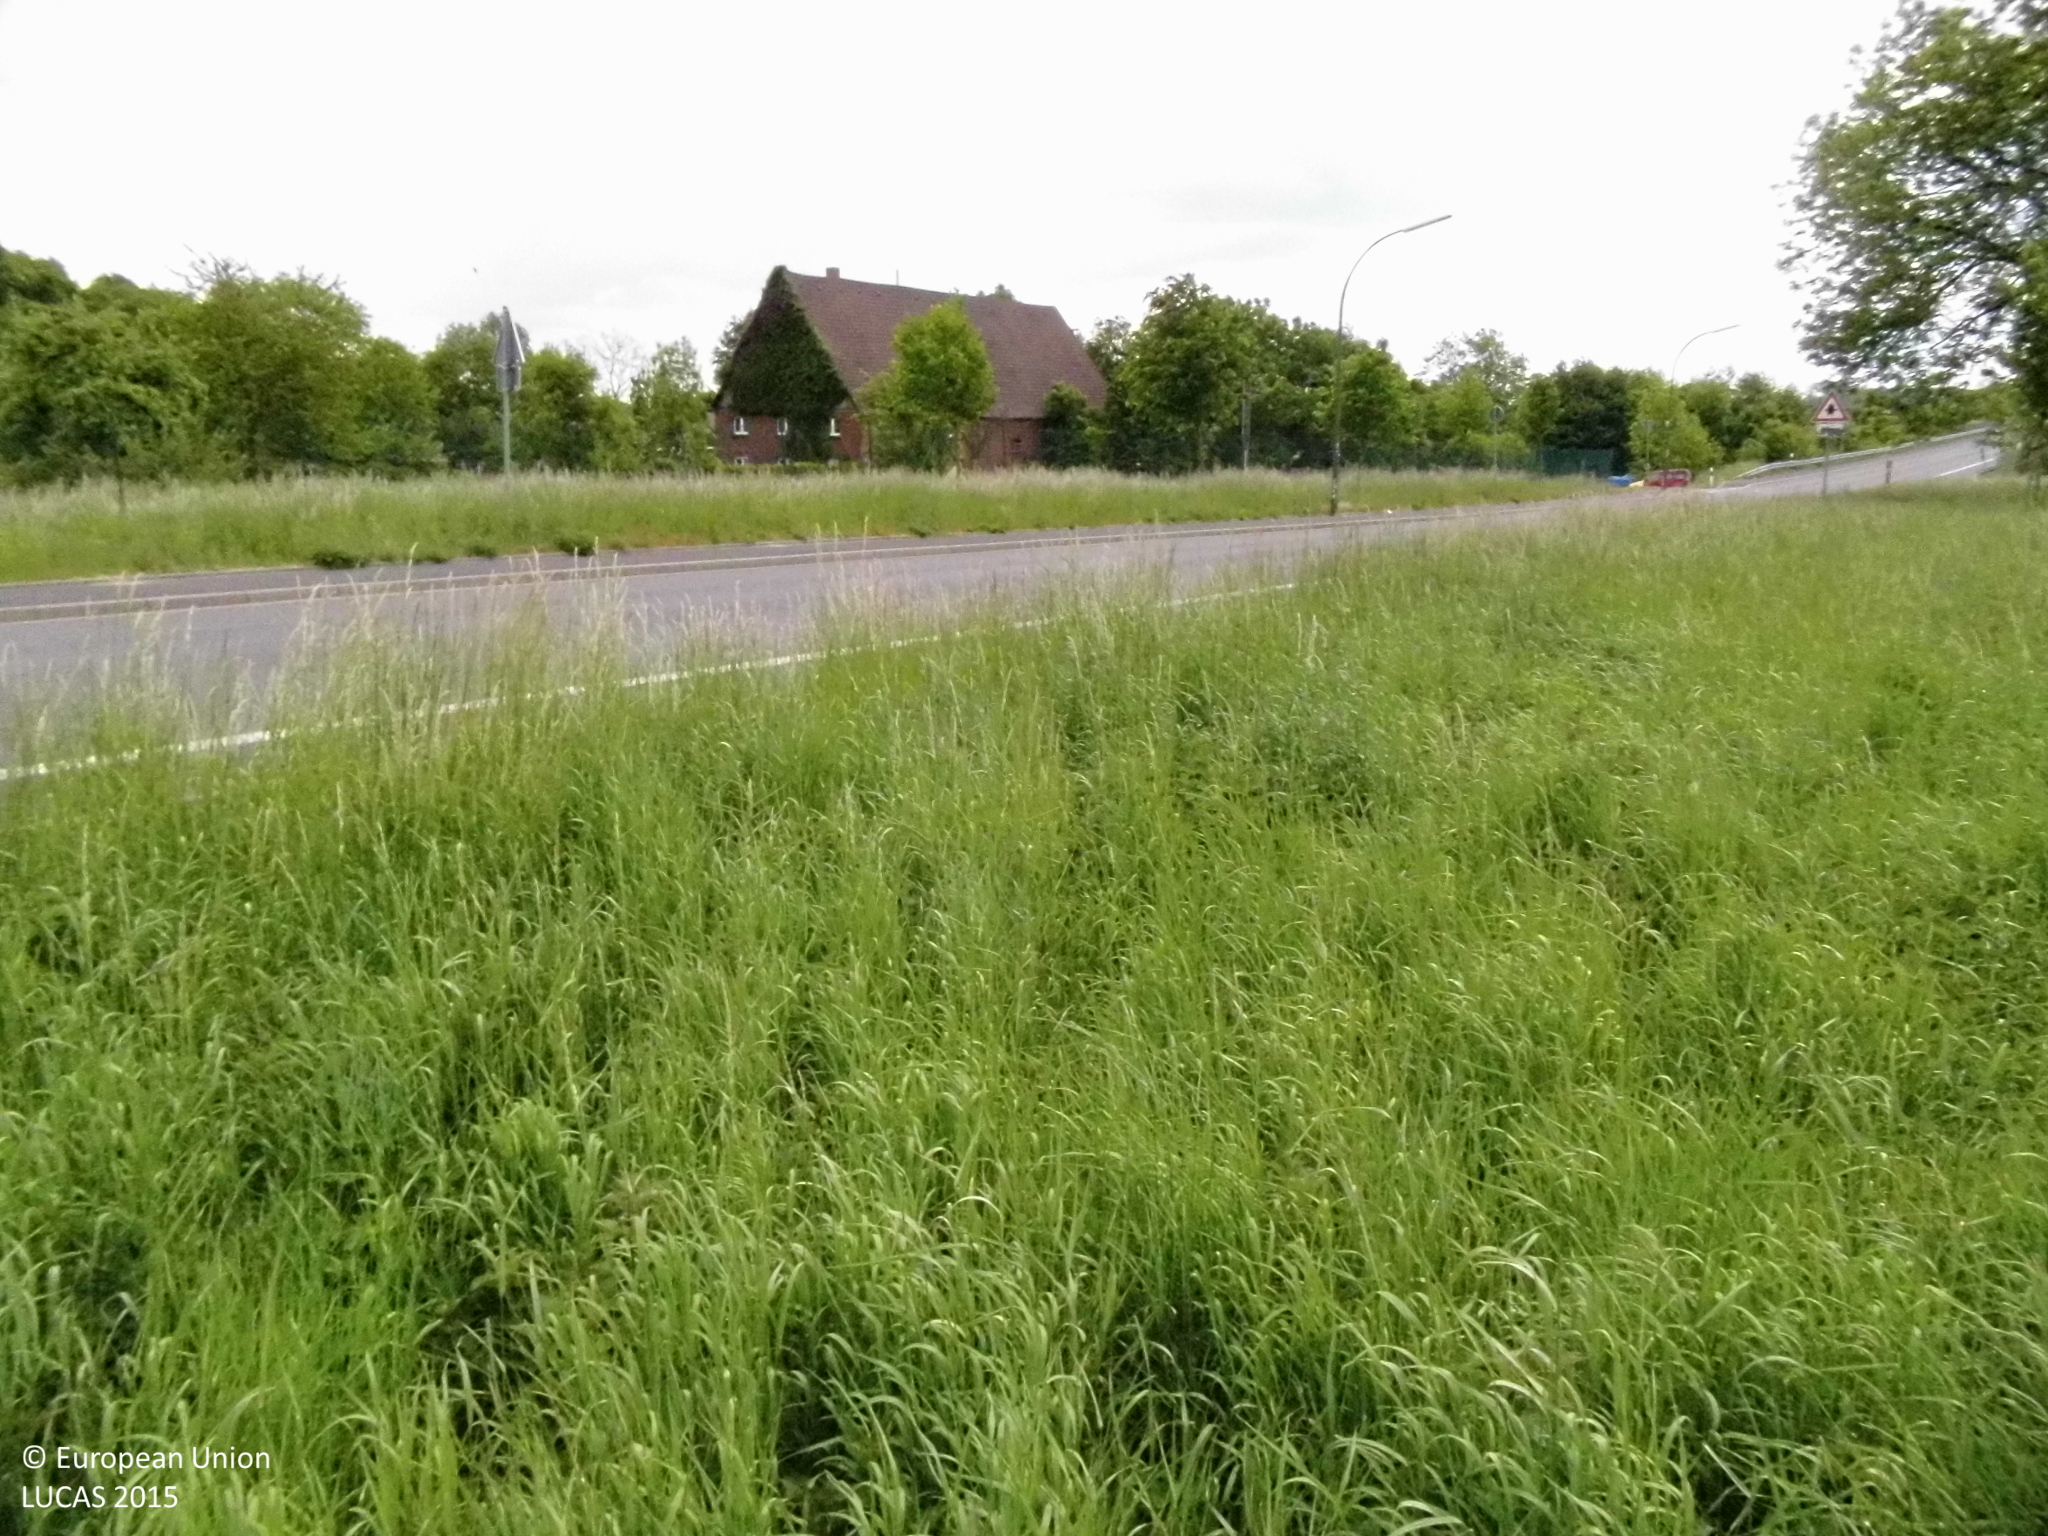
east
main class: Grassland
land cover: Spontaneously vegetated surfaces
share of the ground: > 75 %
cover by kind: herbaceous plants 100 %
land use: Semi-natural and natural areas not in use
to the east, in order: Spontaneously vegetated surfaces; Paved roads, cycling and walking lanes; Grass margins; Lines of trees; Fences; Grassland without tree/shrub cover; Fences; Grassland with sparse tree/shrub cover; Artificial constructions in urban areas; Abandoned hedges; Fences; Grassland without tree/shrub cover; Fences; Grassland without tree/shrub cover; Fences; Broadleaved woodland
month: May
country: DE
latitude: 51.5773
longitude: 7.4750
